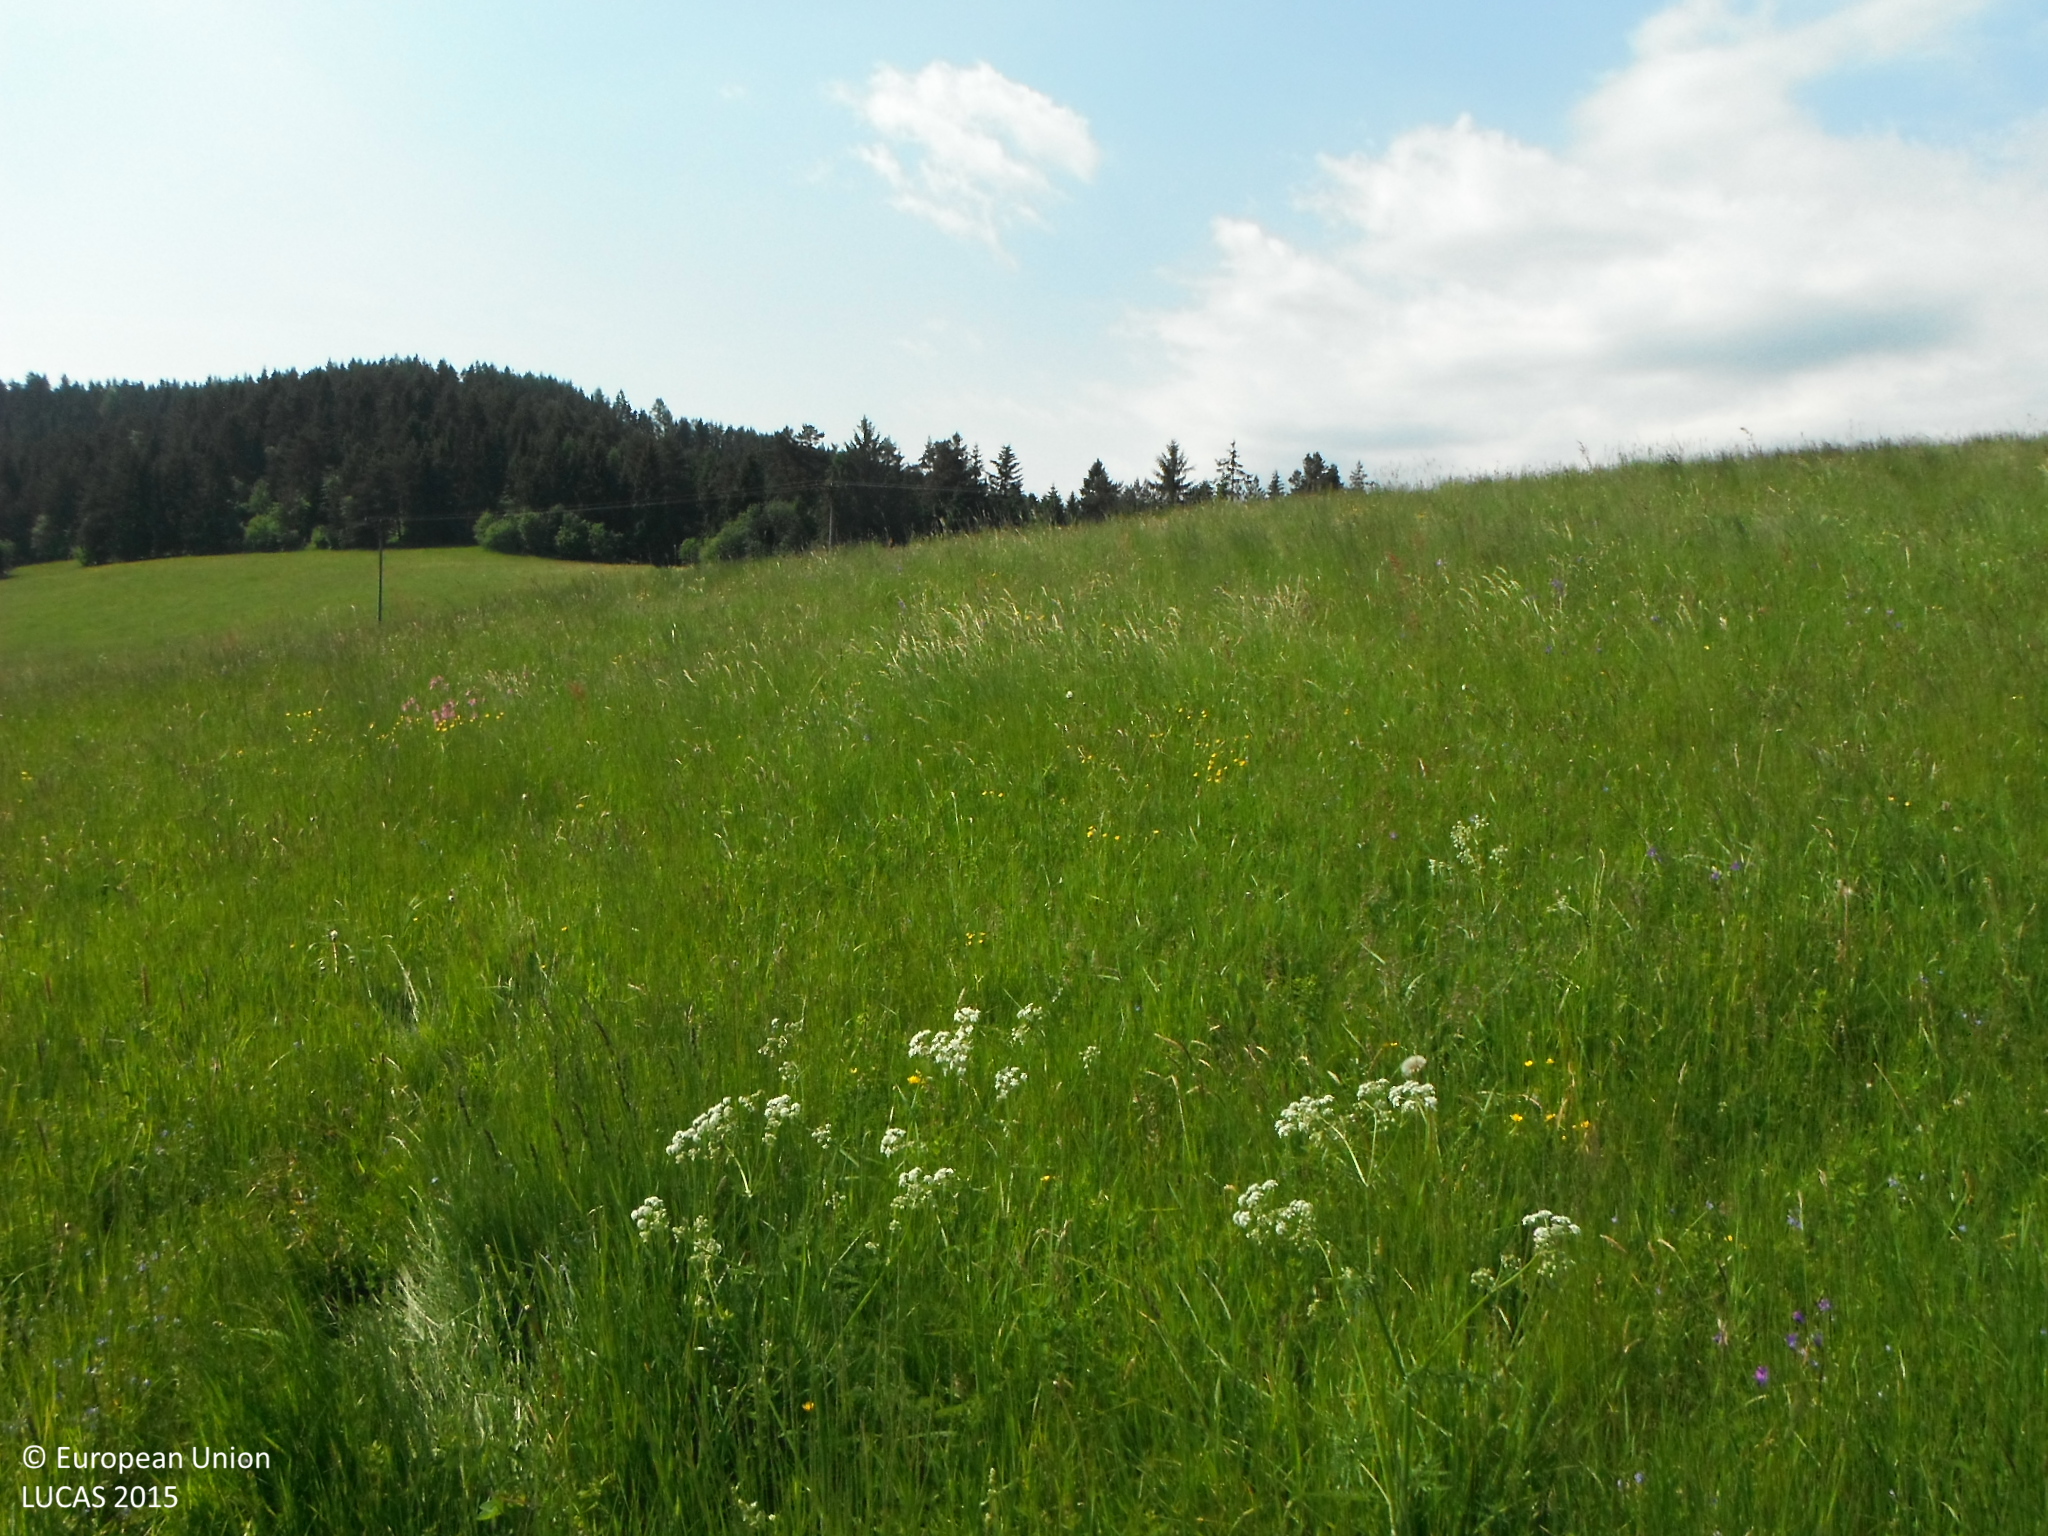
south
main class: Grassland
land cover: Grassland without tree/shrub cover
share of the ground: > 75 %
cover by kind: herbaceous plants 100 %
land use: Agriculture (excluding fallow land and kitchen gardens)
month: June
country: SK
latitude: 49.3471
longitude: 20.3728
